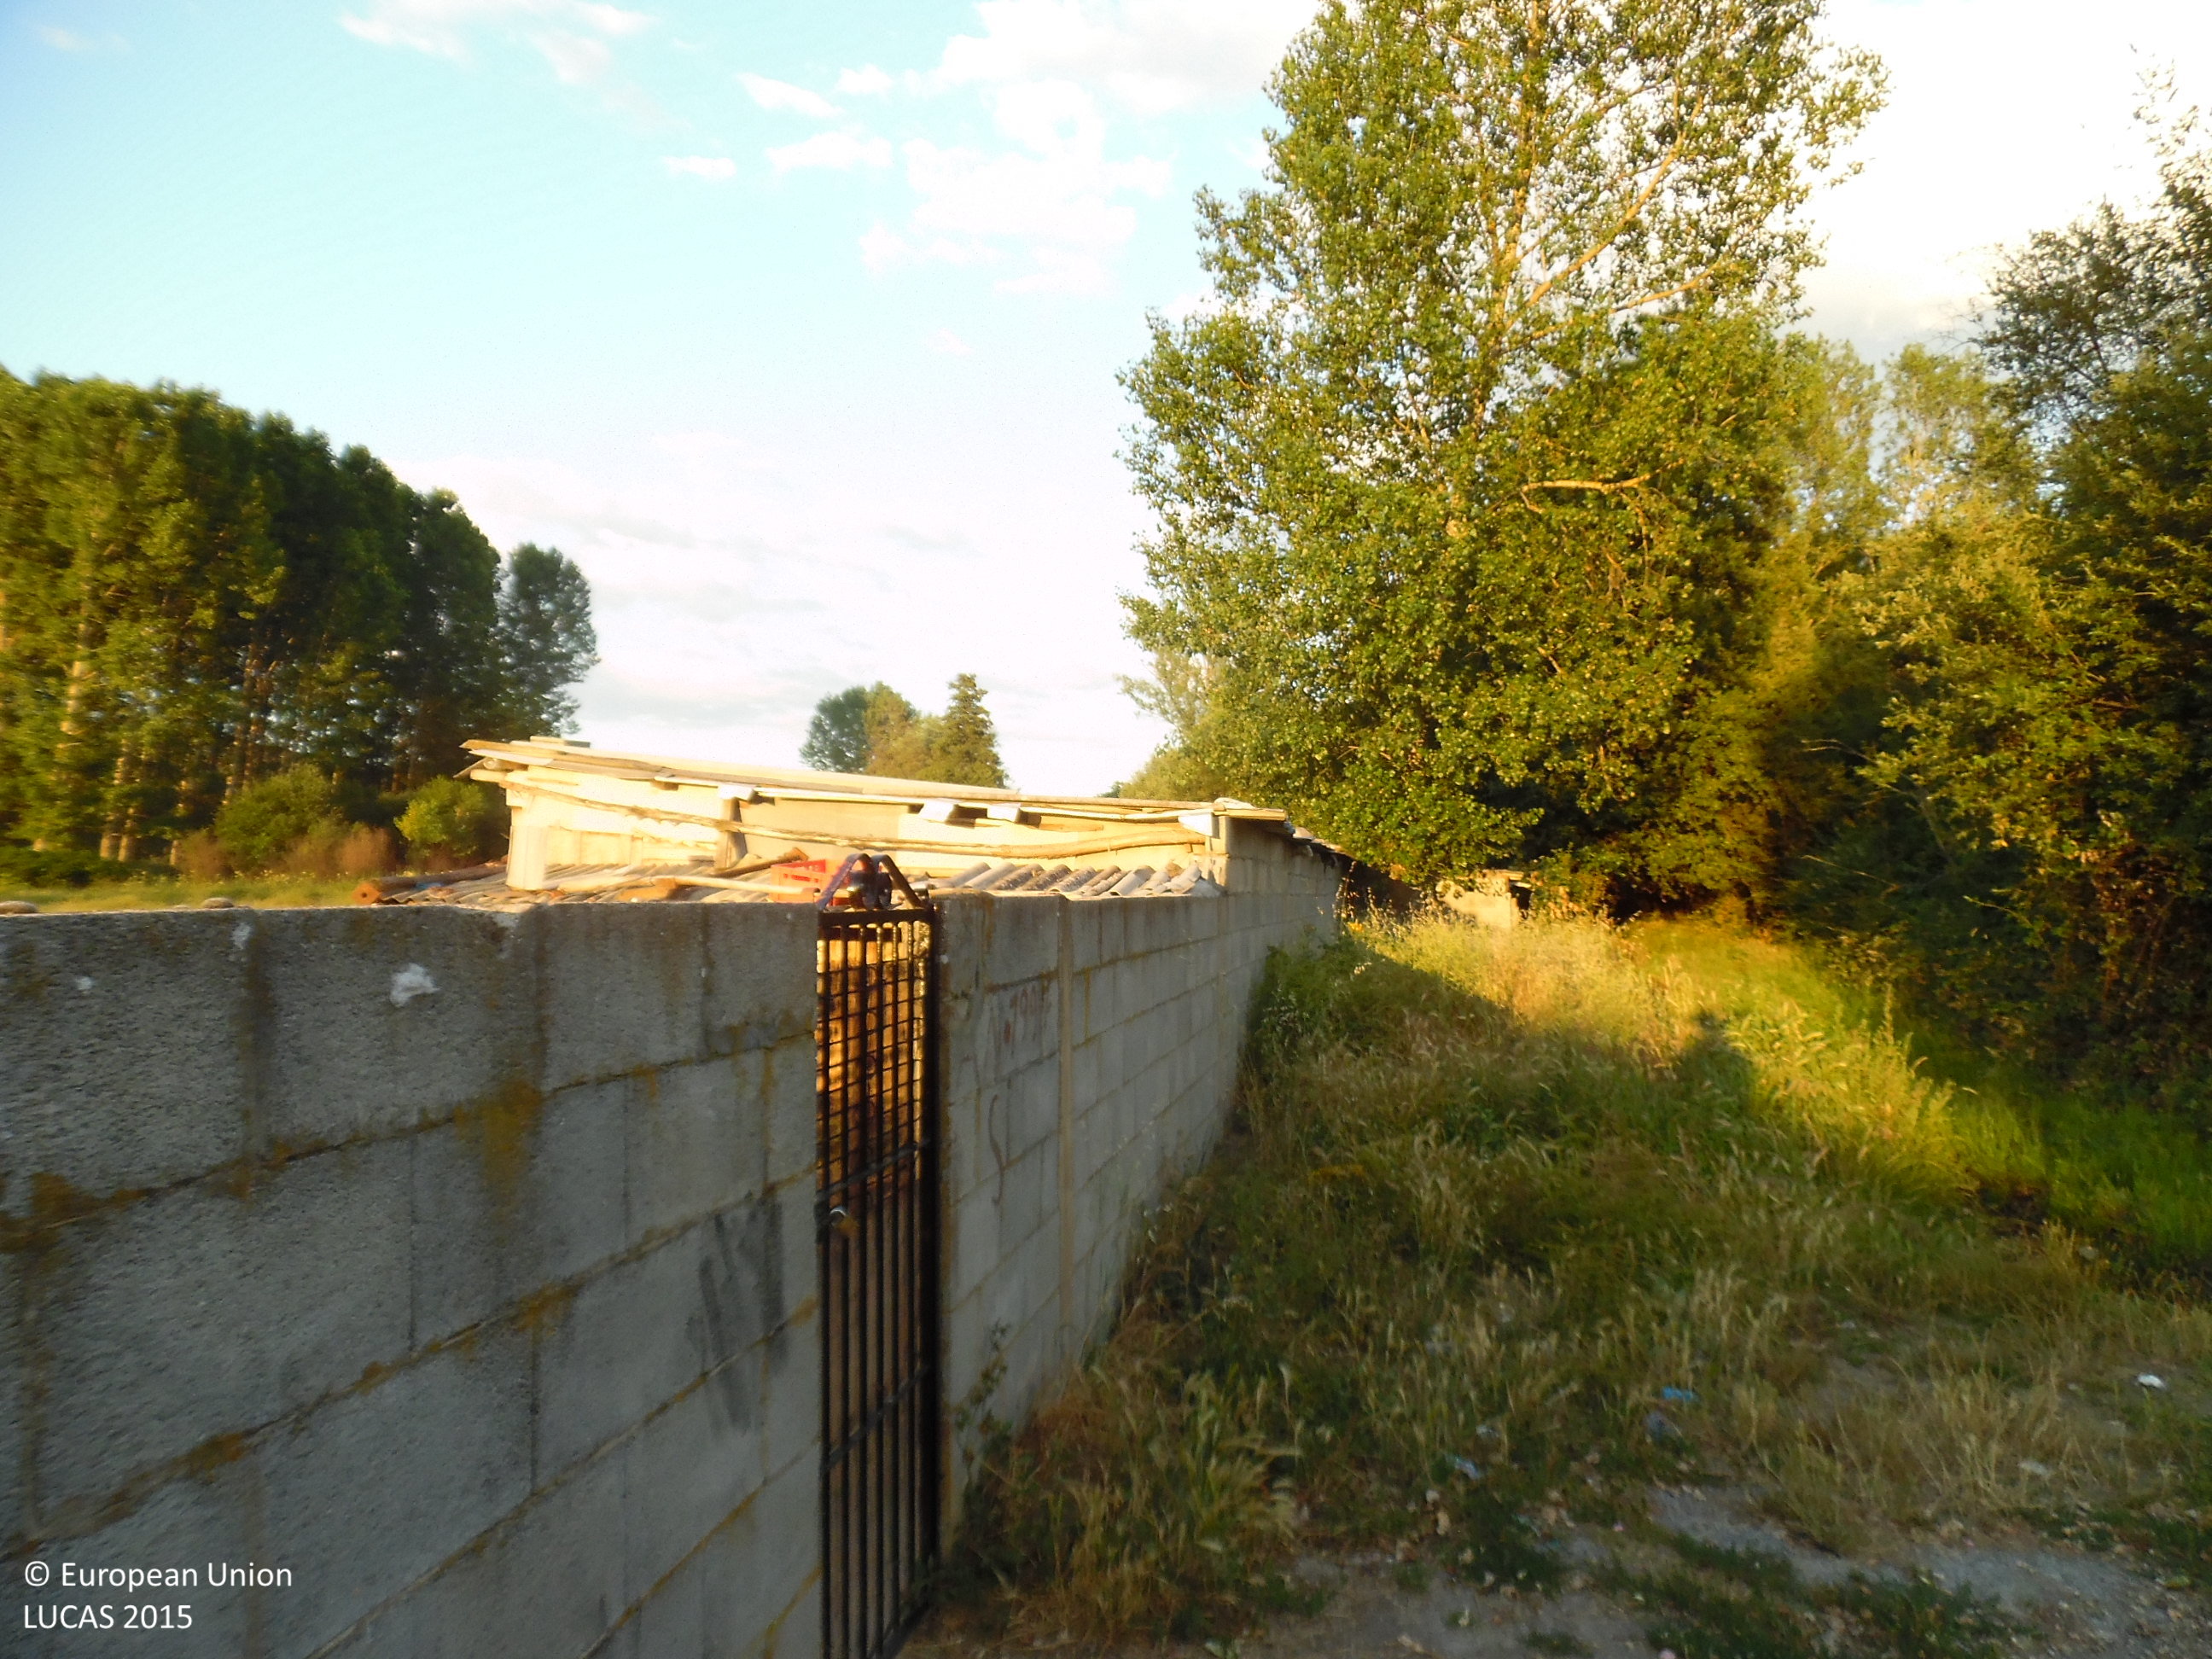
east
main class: Grassland
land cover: Grassland without tree/shrub cover
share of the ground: > 75 %
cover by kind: herbaceous plants 95 %, shrubs 5 %
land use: Agriculture (excluding fallow land and kitchen gardens)
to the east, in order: Grassland without tree/shrub cover; Fences; Grassland without tree/shrub cover; Broadleaved woodland; Fences; Rivers and streams; Abandoned hedges; Cherry fruit; Grassland without tree/shrub cover; Abandoned hedges; Grassland without tree/shrub cover; Dry stone walls; Ditches and canals; Fences; Lucerne; Fences; Grassland without tree/shrub cover; Fences; Abandoned hedges
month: June
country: ES
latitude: 42.6099
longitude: -6.4139
